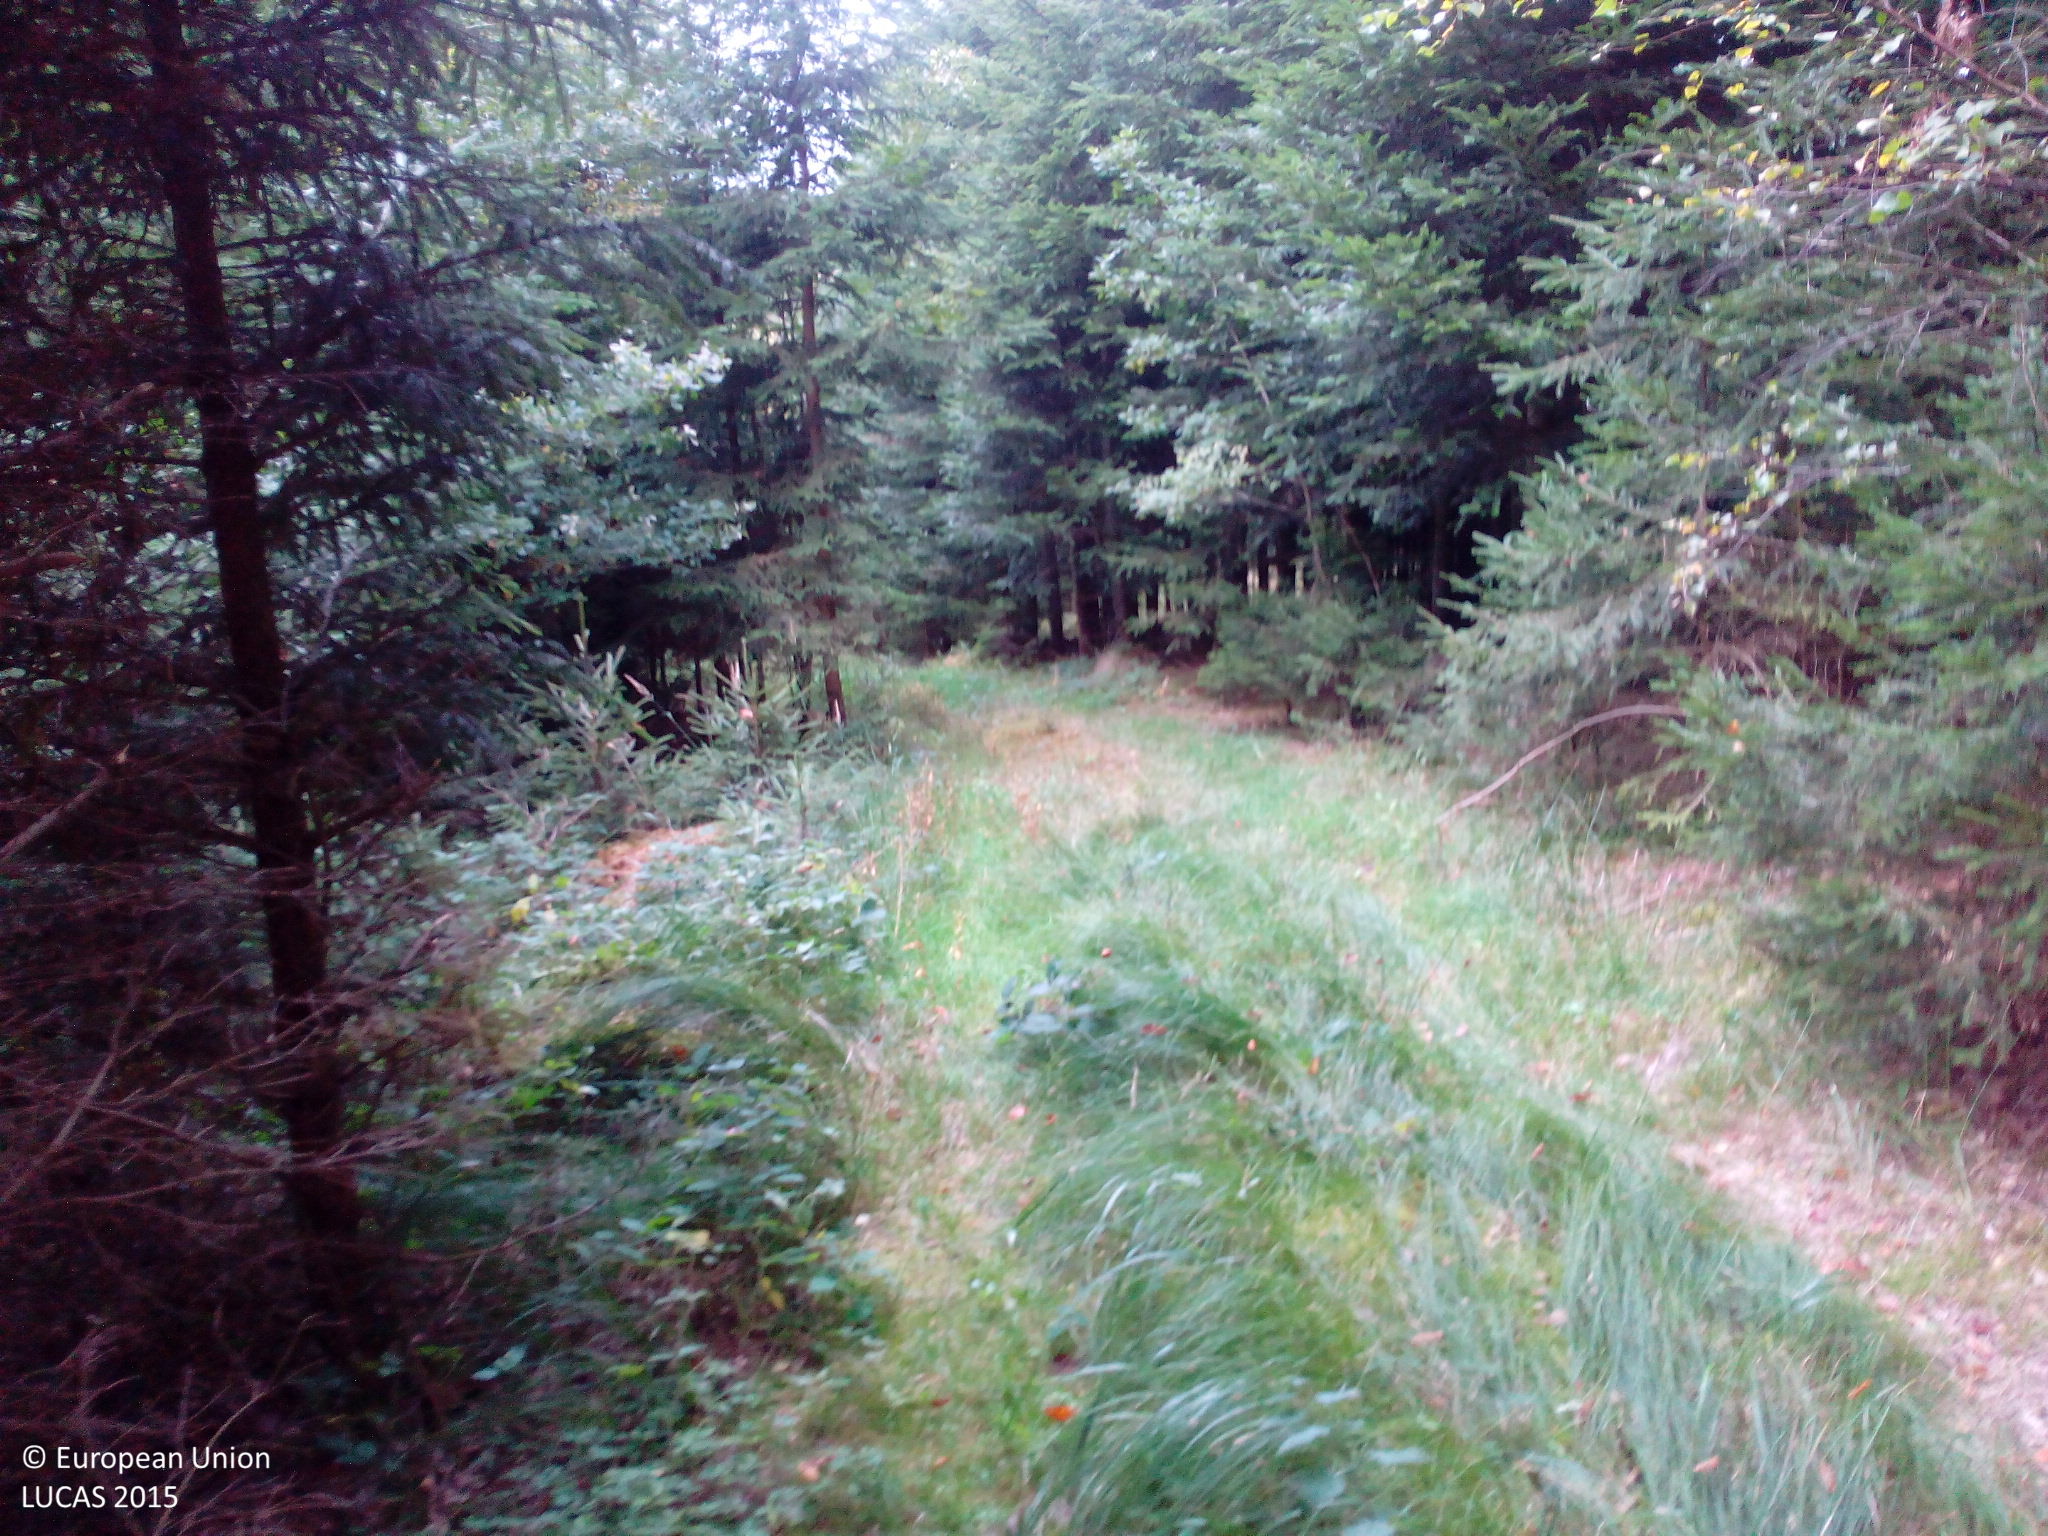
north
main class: Woodland
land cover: Spruce dominated coniferous woodland
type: hemiboreal forest and nemoral coniferous forest and mixed broadleaved-coniferous forest
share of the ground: > 75 %
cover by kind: coniferous forest trees 100 %
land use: Forestry
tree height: > 5 m
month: September
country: DE
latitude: 48.4836
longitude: 11.4740
